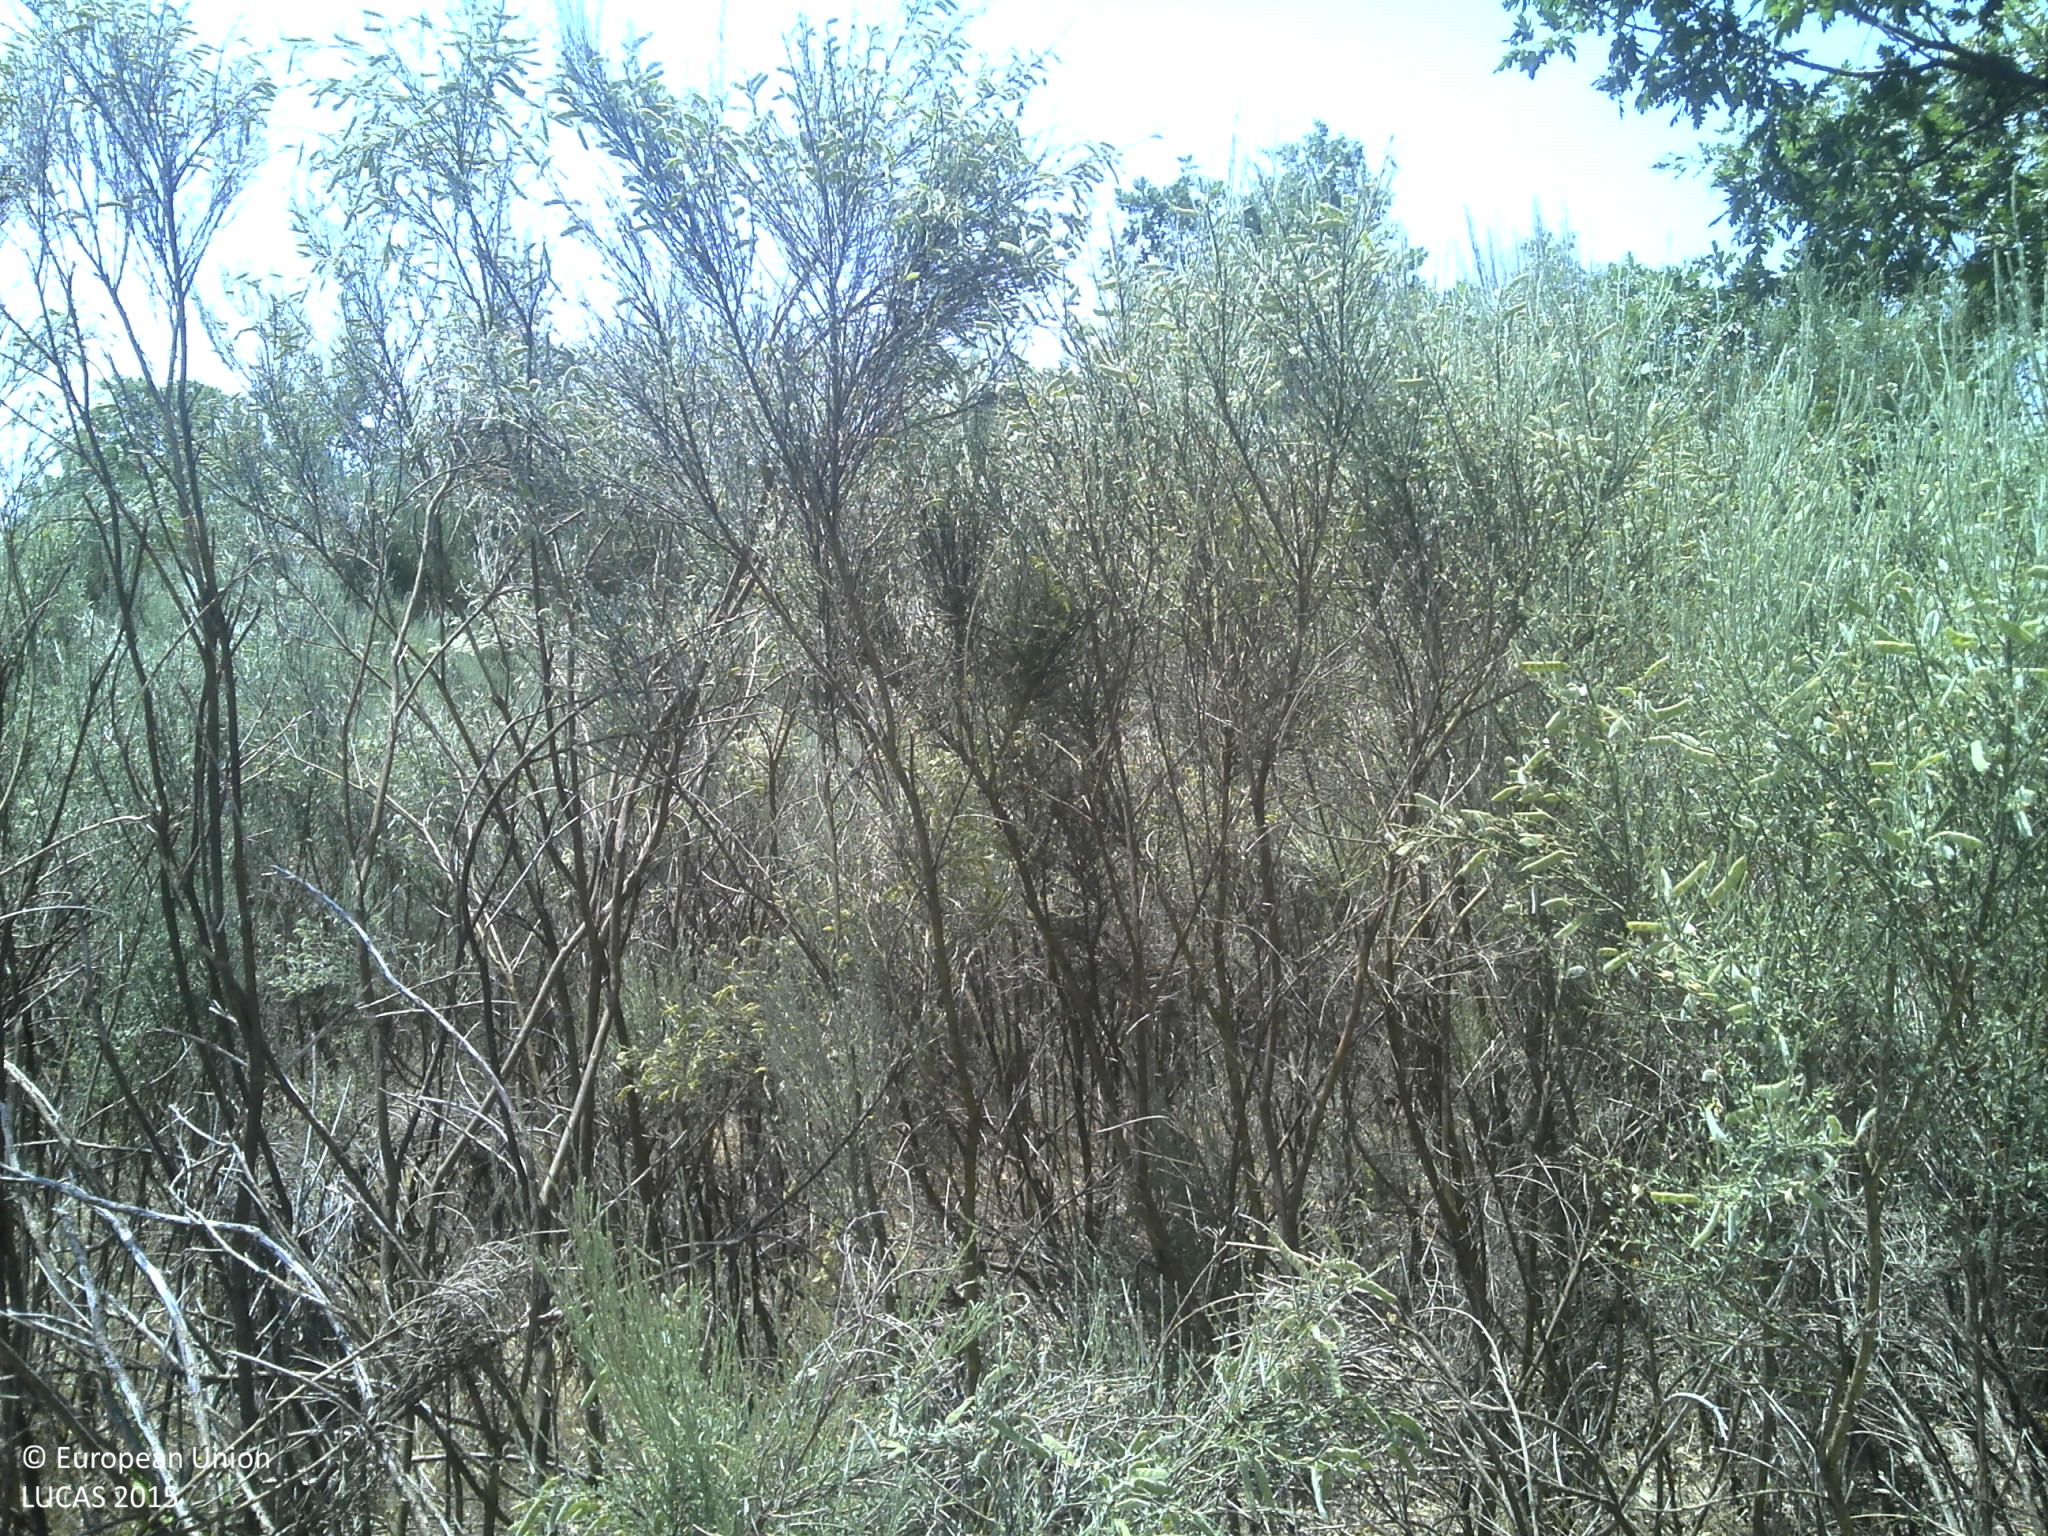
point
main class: Shrubland
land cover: Shrubland with sparse tree cover
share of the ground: 50 - 75 %
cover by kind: shrubs 70 %, unconsolidated bare surface 10 %, broadleaved forest trees 5 %, herbaceous plants 5 %
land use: Forestry
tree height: > 5 m
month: June
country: PT
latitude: 40.3646
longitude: -6.8506
